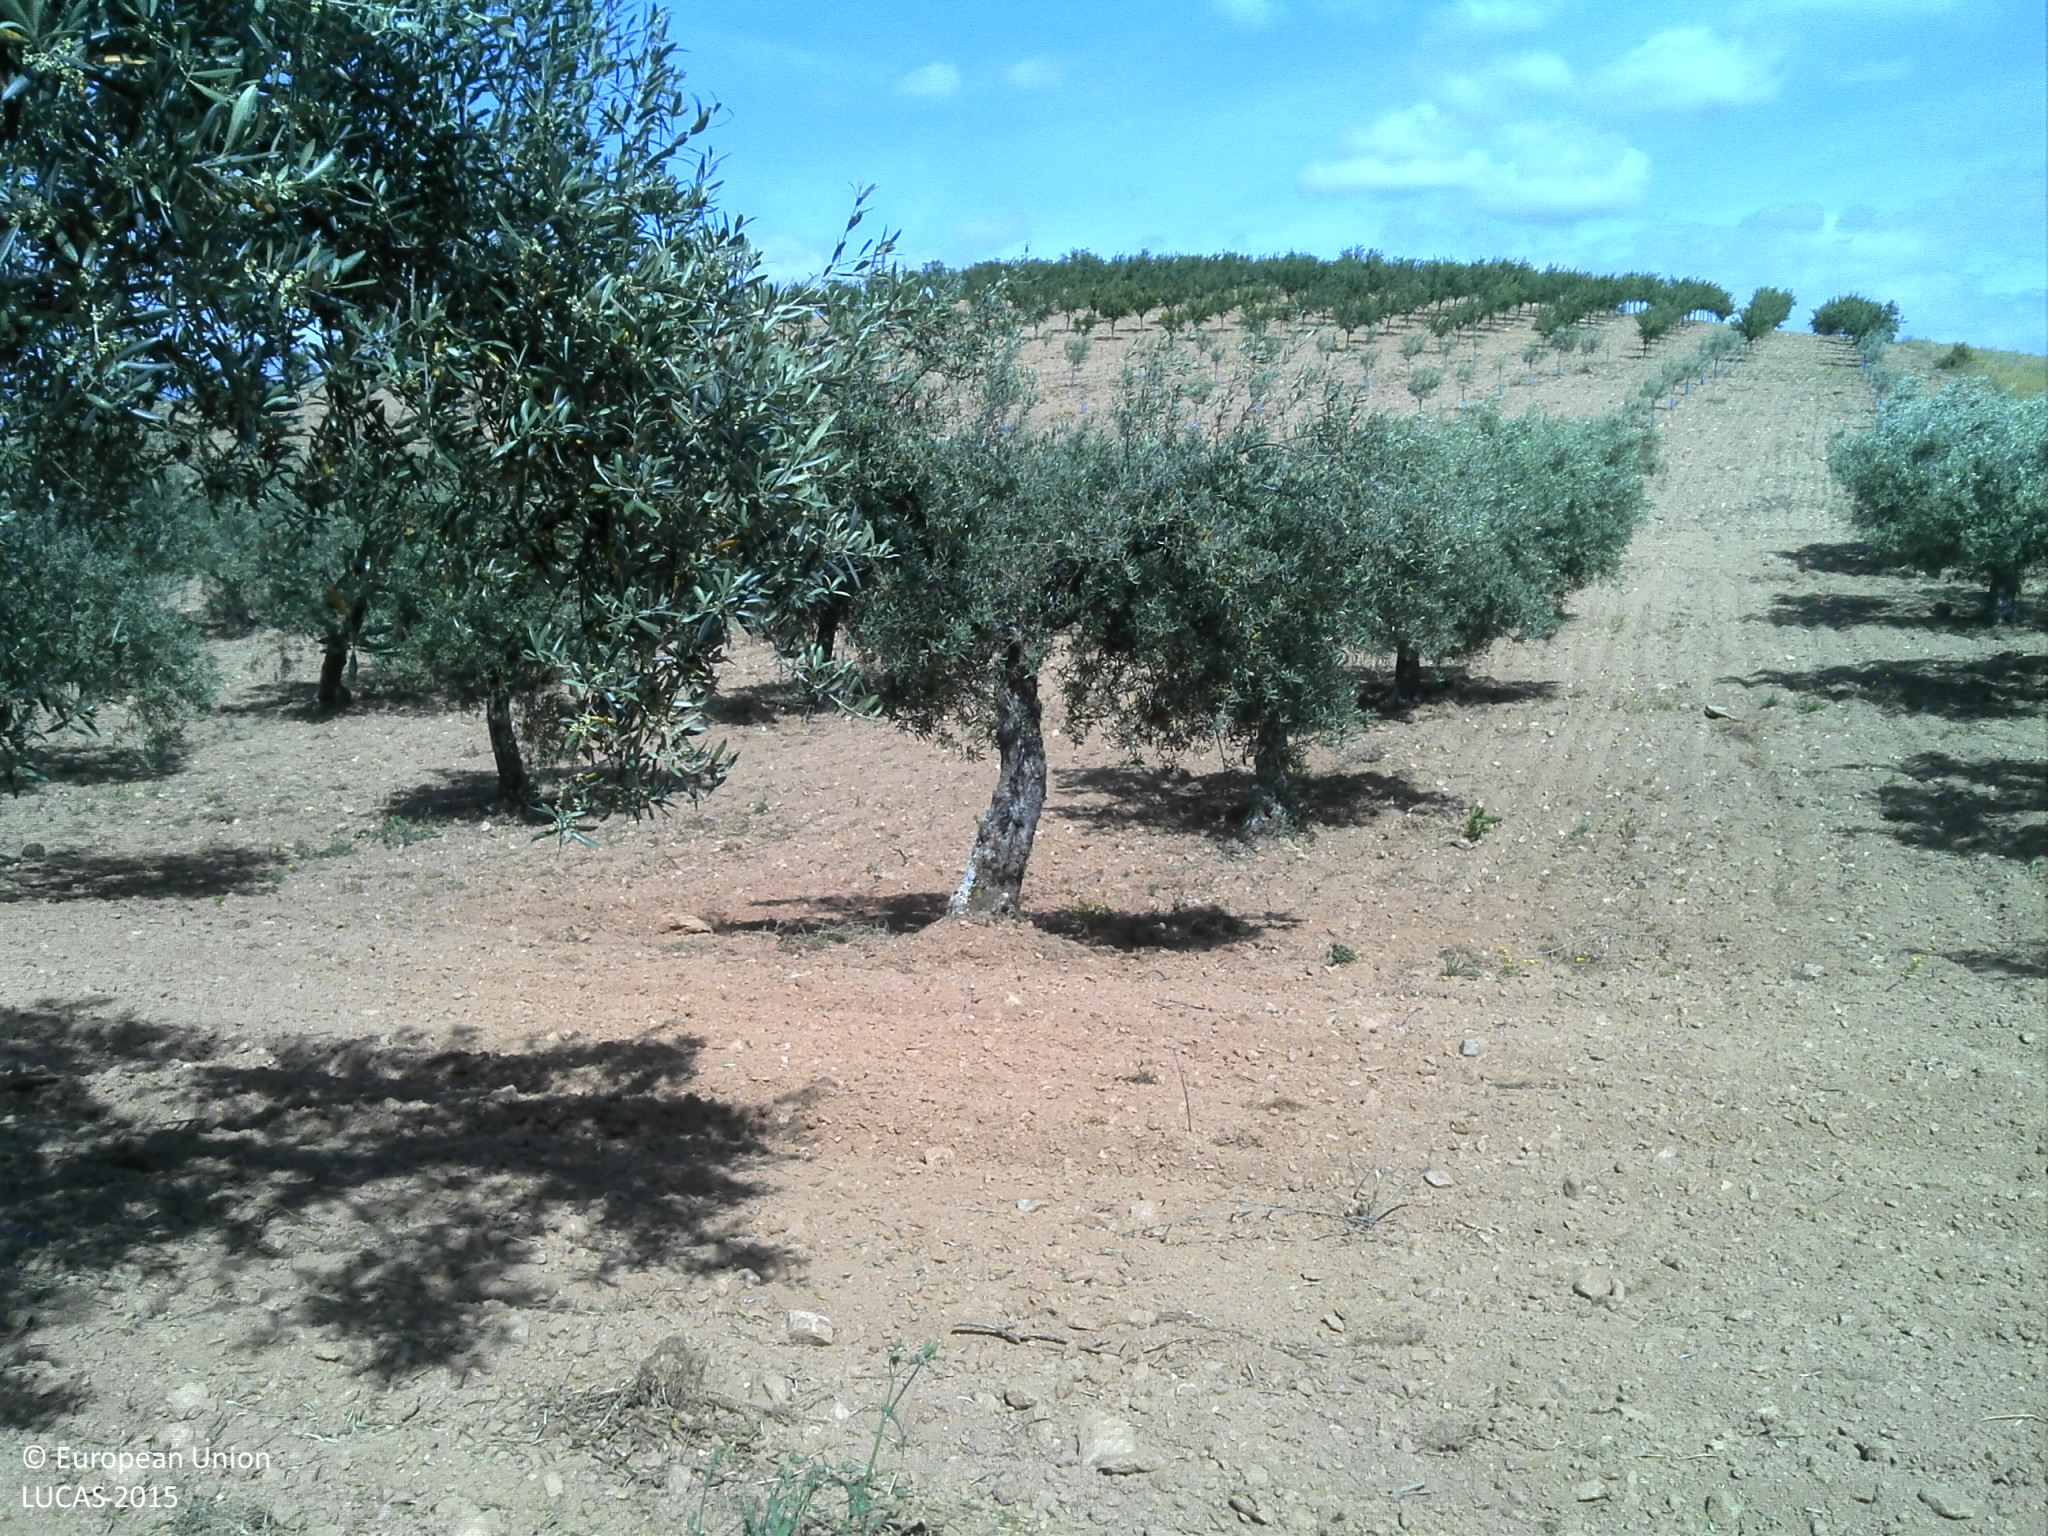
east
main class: Cropland
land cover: Olive groves
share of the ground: 10 - 25 %
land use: Agriculture (excluding fallow land and kitchen gardens)
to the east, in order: Olive groves; Nuts trees; Grassland without tree/shrub cover; Shrubland without tree cover; Shrubland with sparse tree cover; Shrubland without tree cover; Shrubland with sparse tree cover
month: May
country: PT
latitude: 41.5432
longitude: -7.2761
